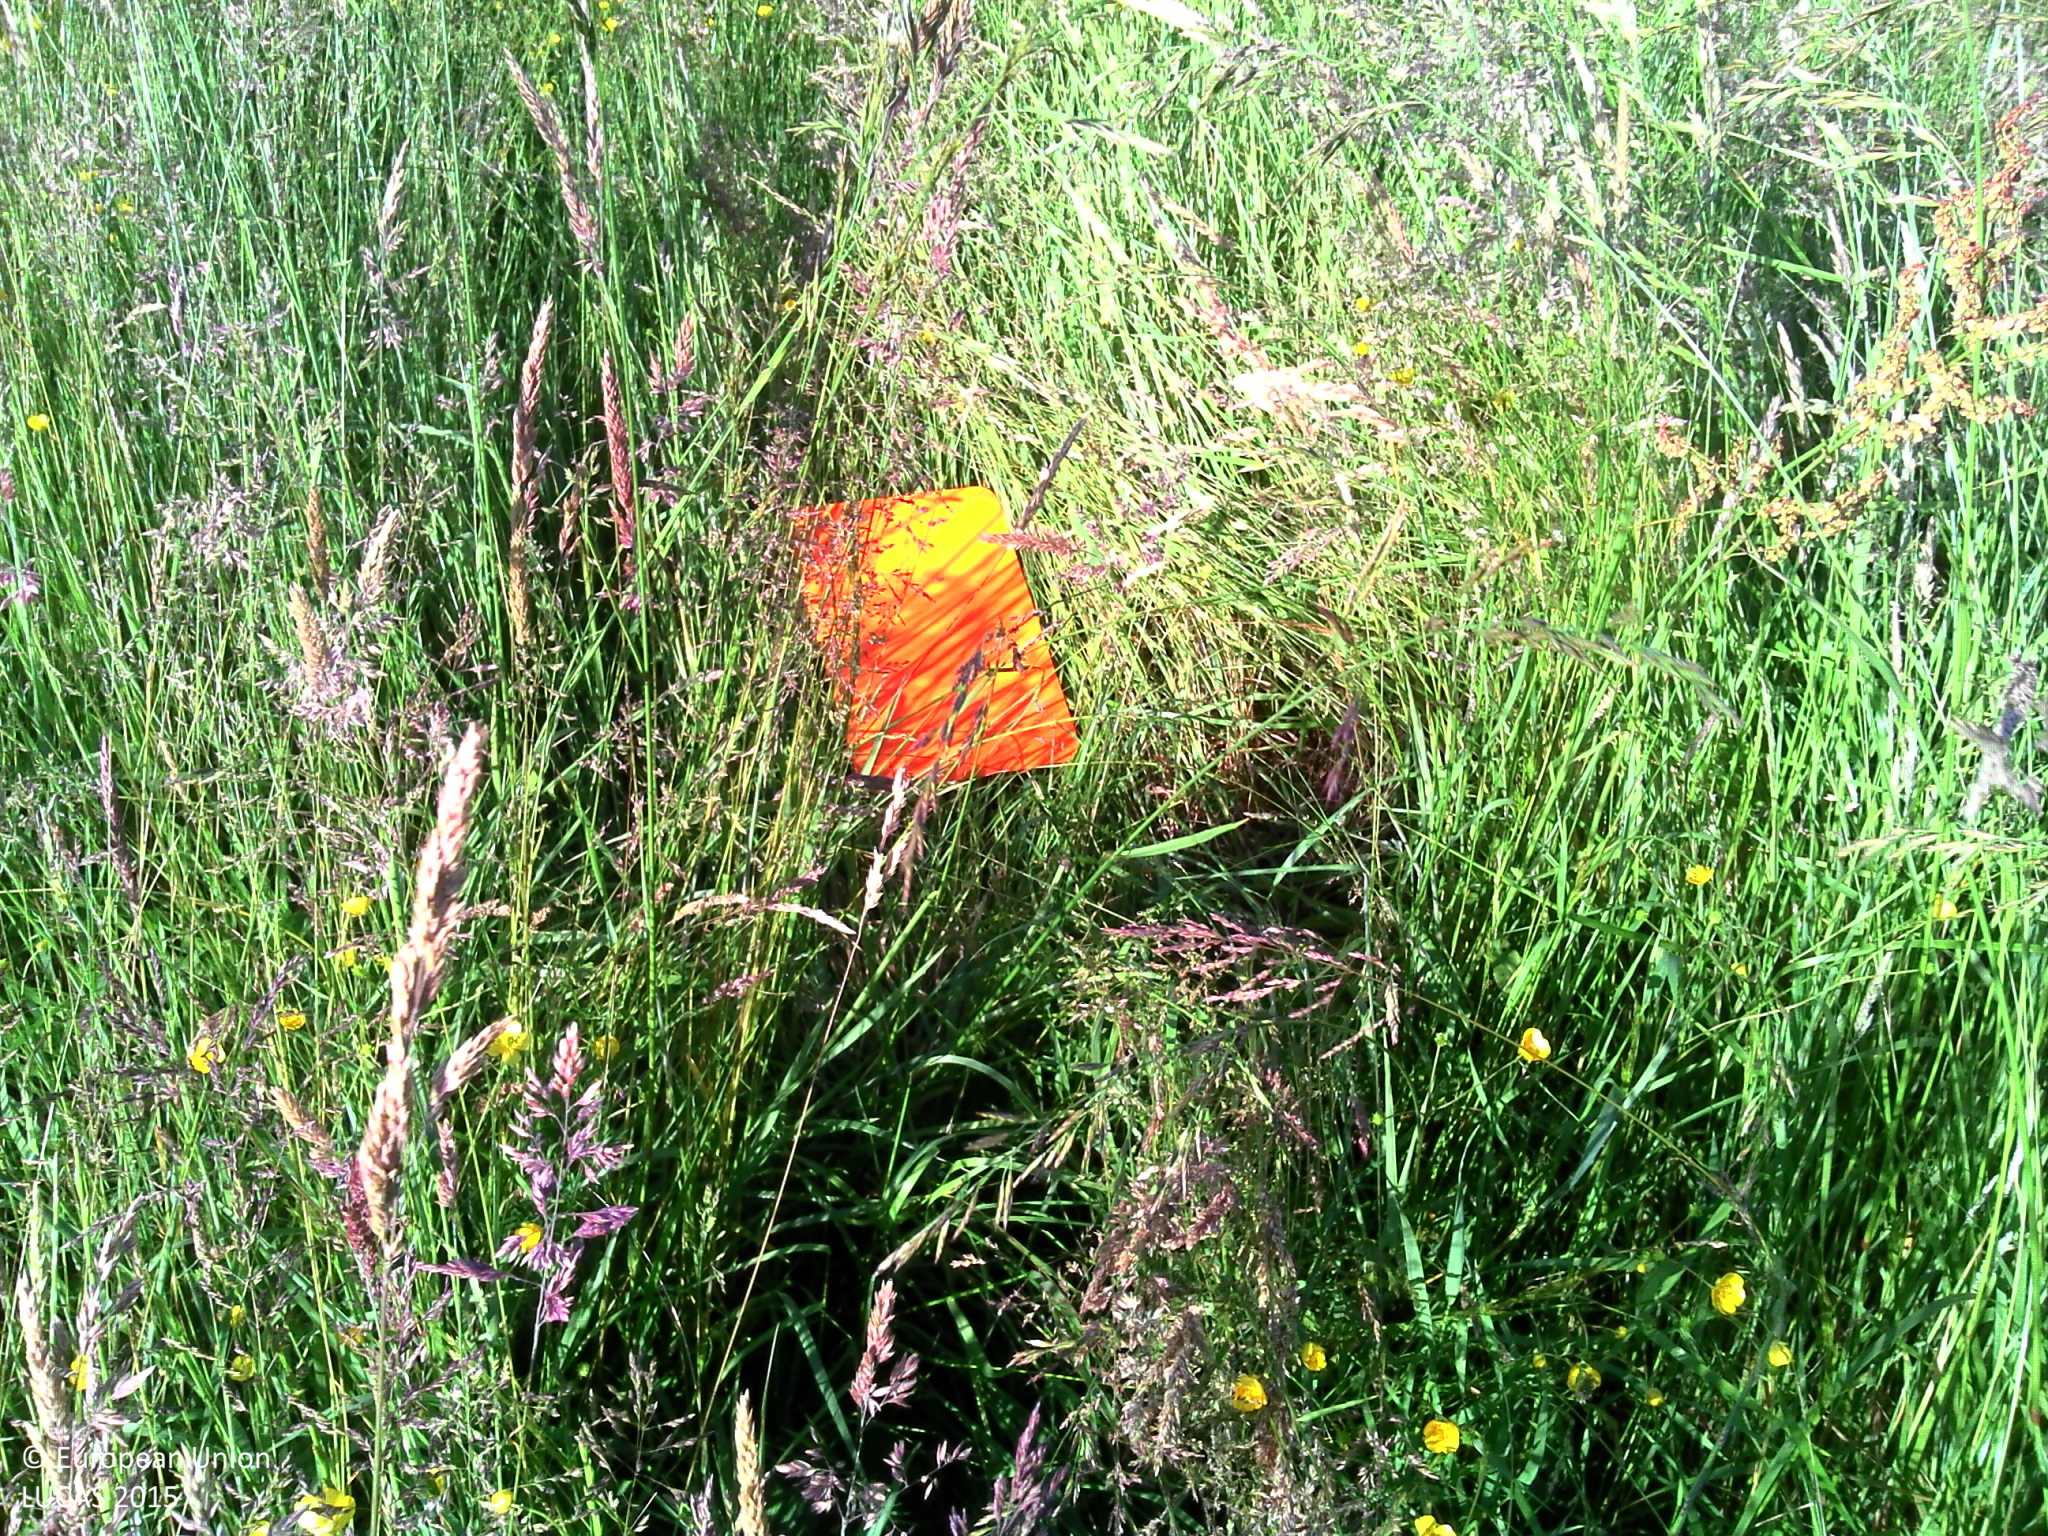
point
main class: Grassland
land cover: Grassland without tree/shrub cover
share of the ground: > 75 %
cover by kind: herbaceous plants 100 %
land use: Agriculture (excluding fallow land and kitchen gardens)
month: June
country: FR
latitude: 49.1768
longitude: 0.3564
